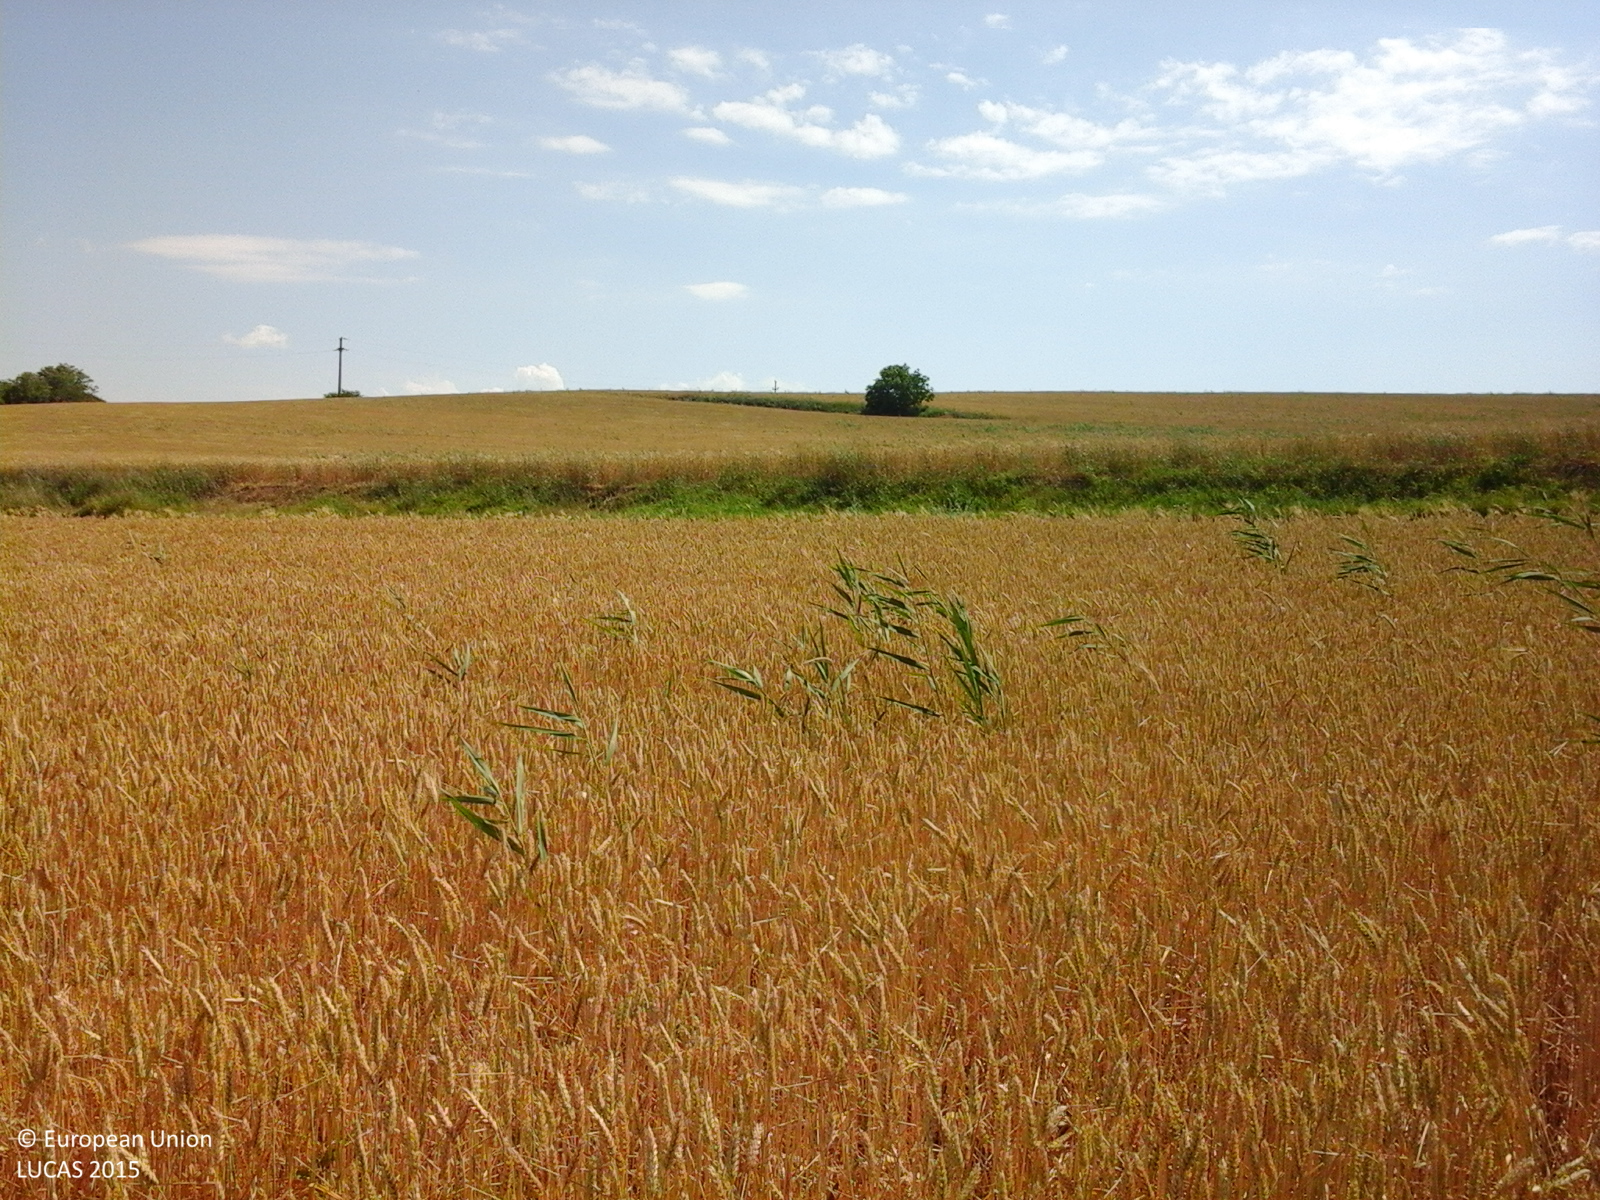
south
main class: Cropland
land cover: Common wheat
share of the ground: > 75 %
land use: Agriculture (excluding fallow land and kitchen gardens)
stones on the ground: < 10 %
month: June
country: RO
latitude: 46.8620
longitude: 28.0630
